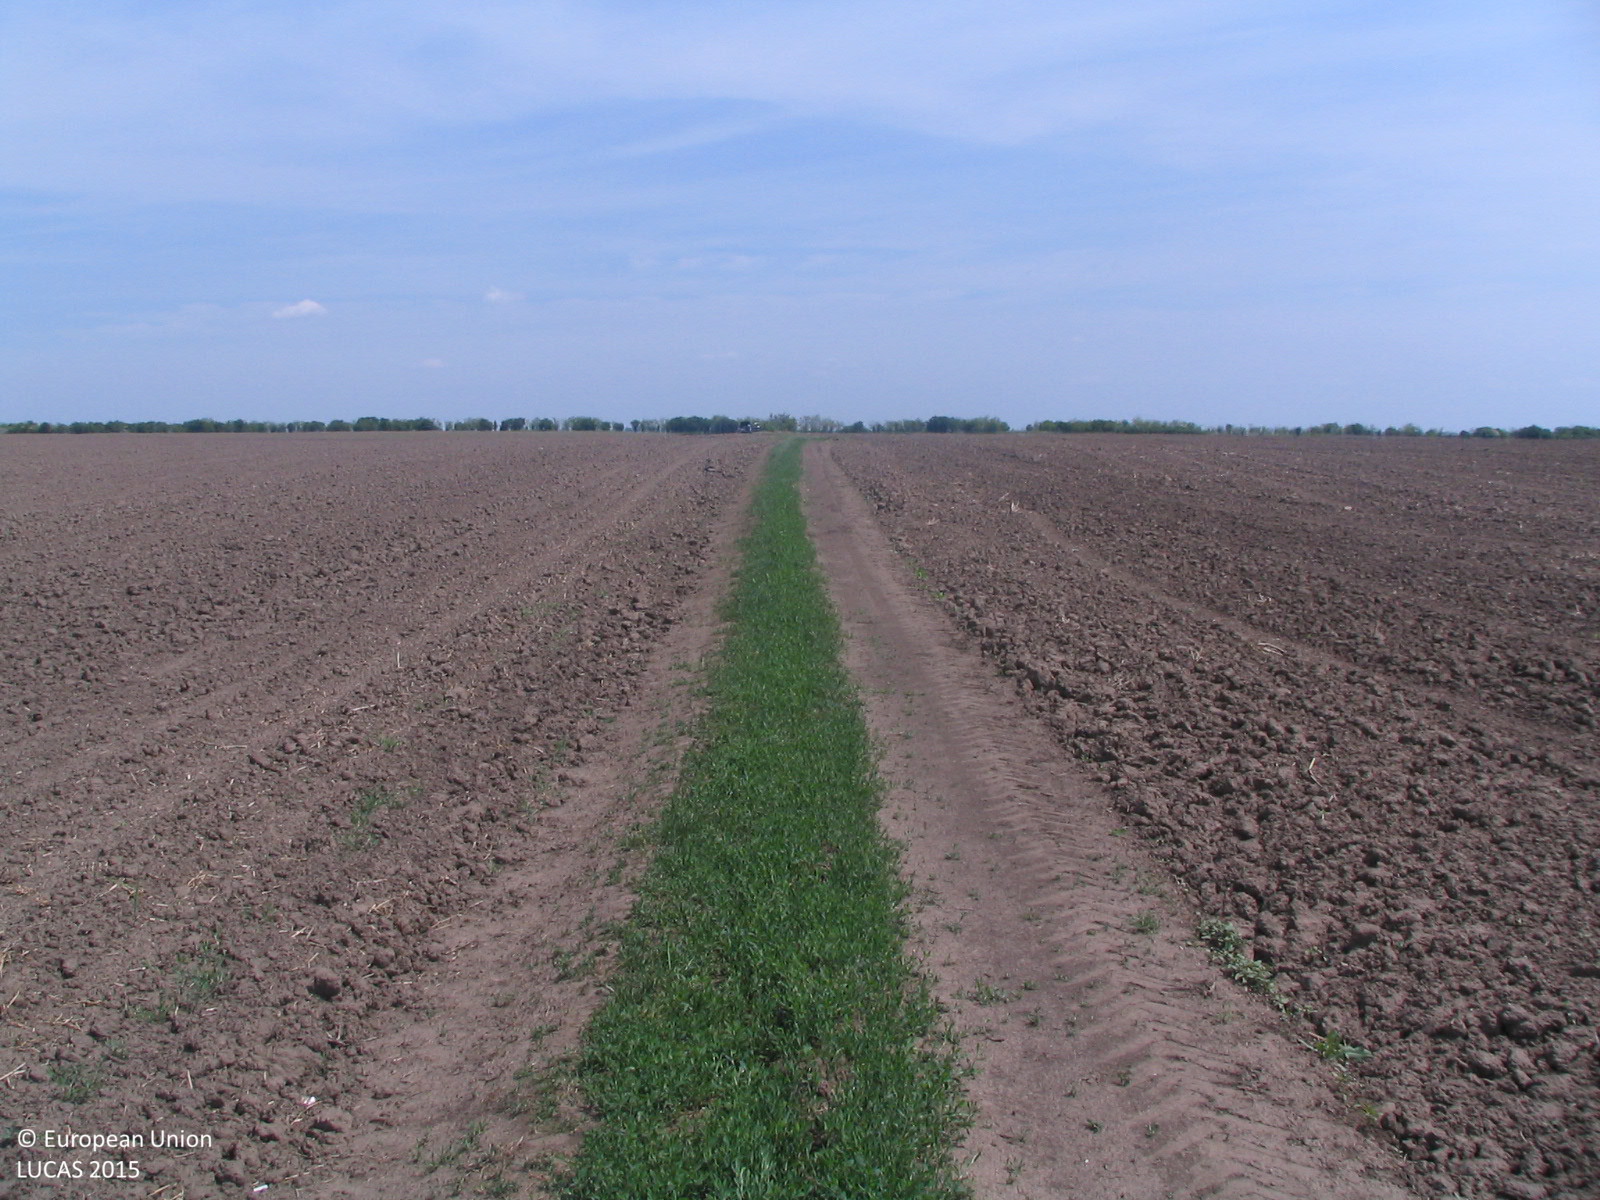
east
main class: Cropland
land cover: Sunflower
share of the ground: < 10 %
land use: Agriculture (excluding fallow land and kitchen gardens)
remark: Harvested field
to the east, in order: Tracks; Sunflower
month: May
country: BG
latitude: 43.6373
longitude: 23.9739
